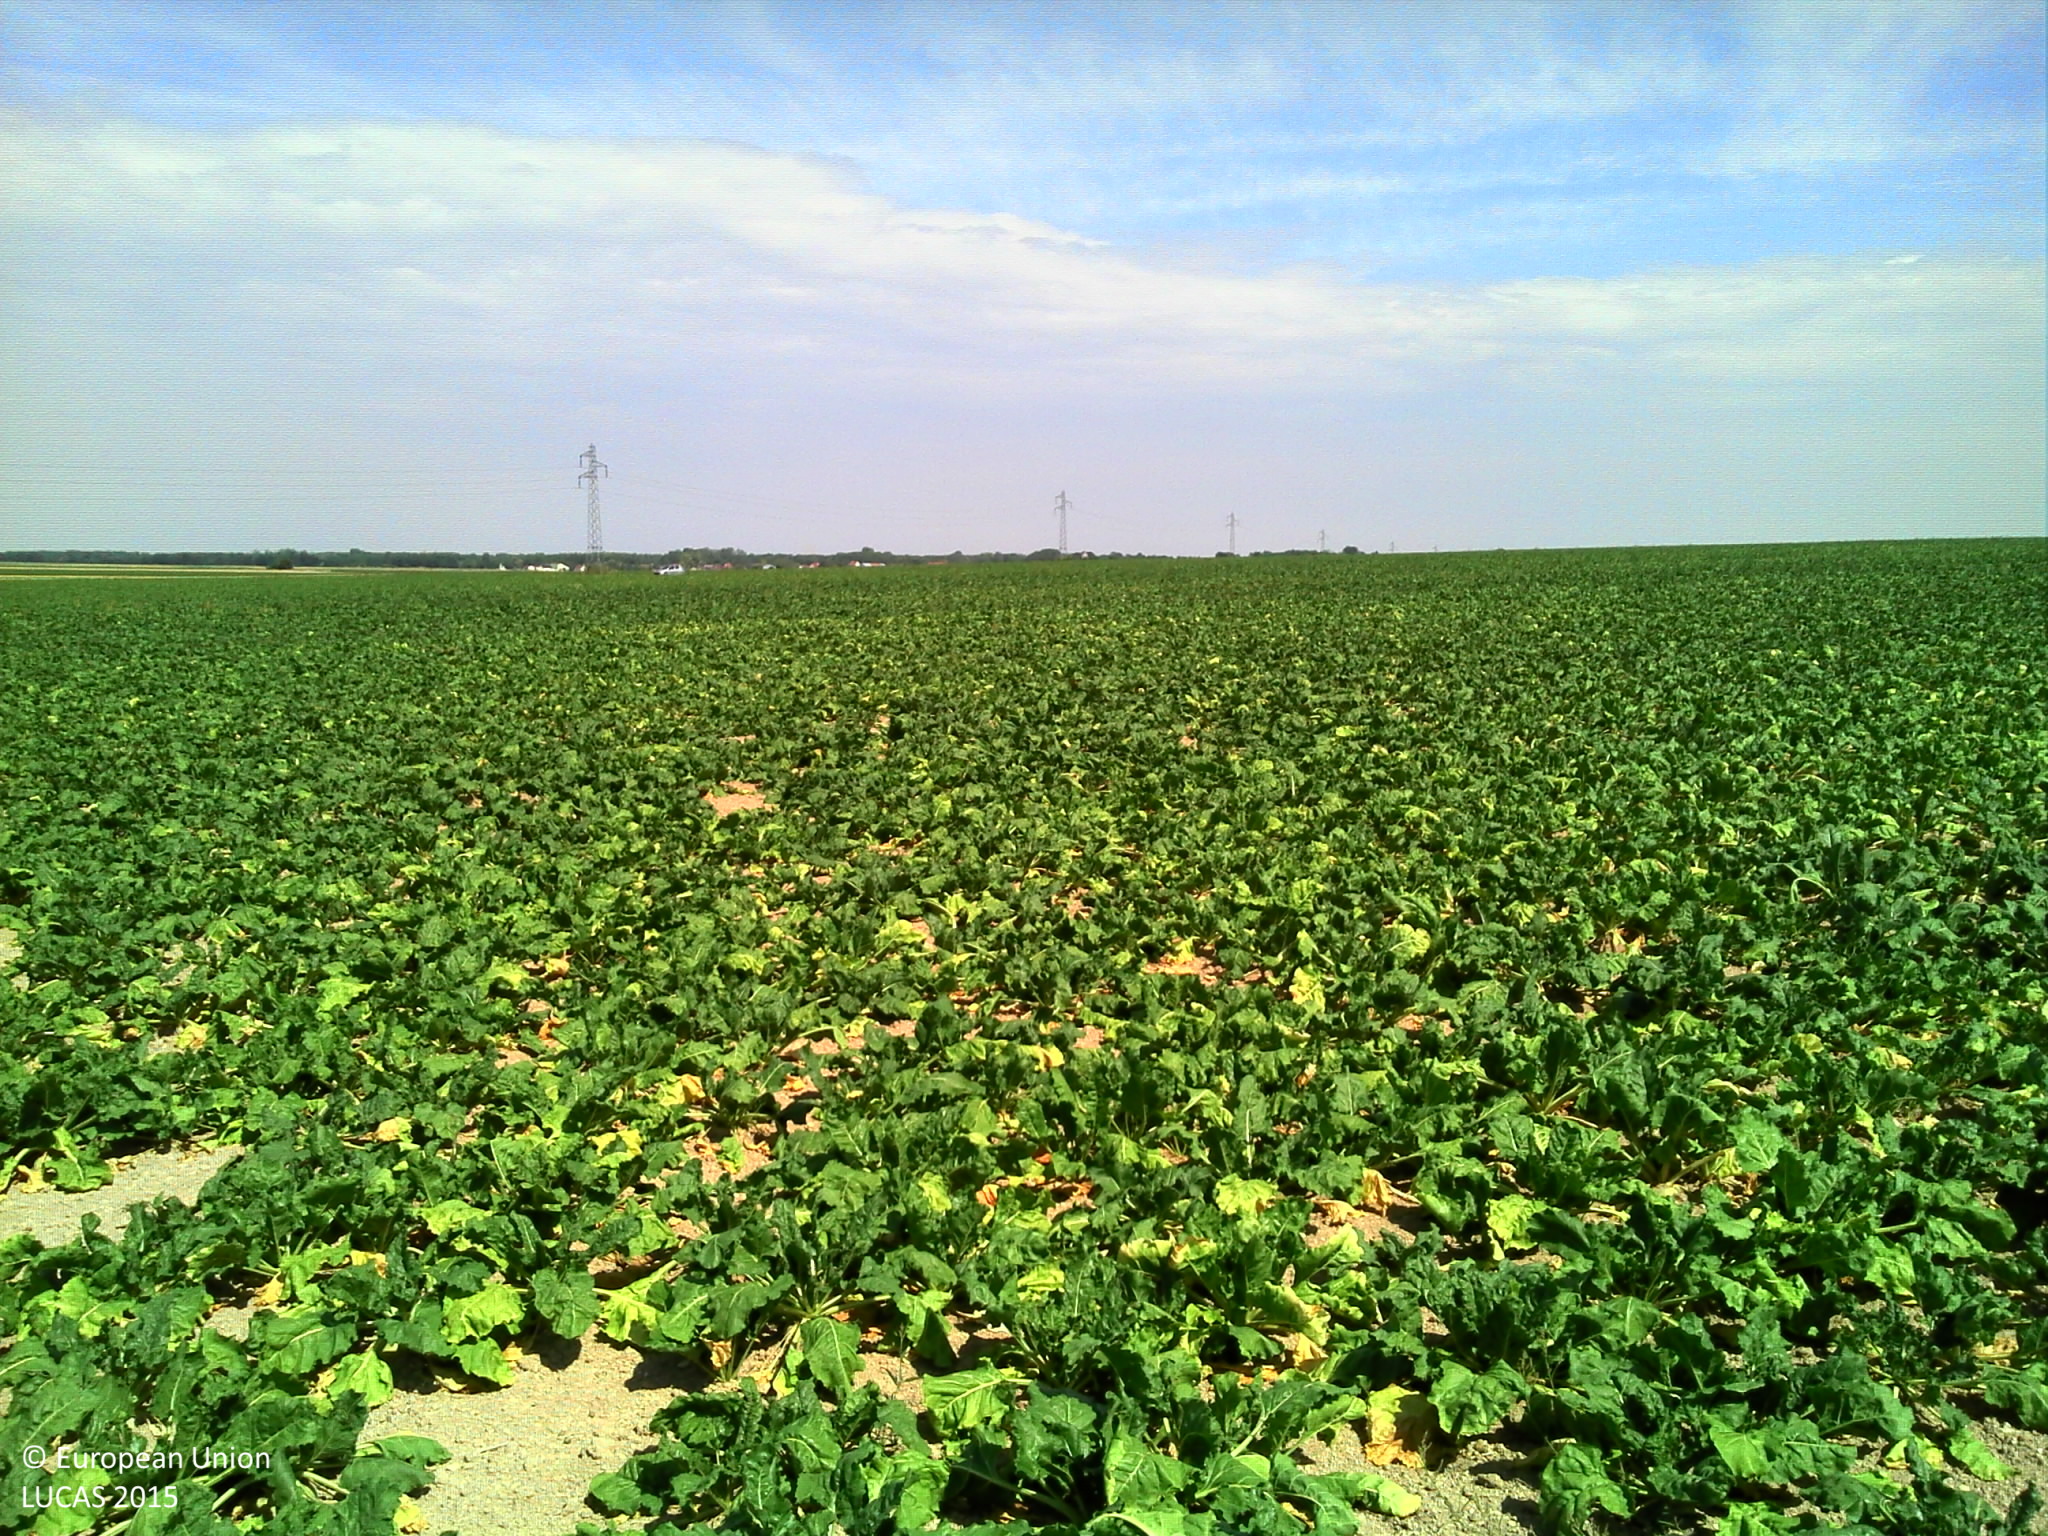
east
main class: Cropland
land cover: Sugar beet
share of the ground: > 75 %
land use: Agriculture (excluding fallow land and kitchen gardens)
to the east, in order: Sugar beet
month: August
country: FR
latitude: 48.9694
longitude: 4.1353
